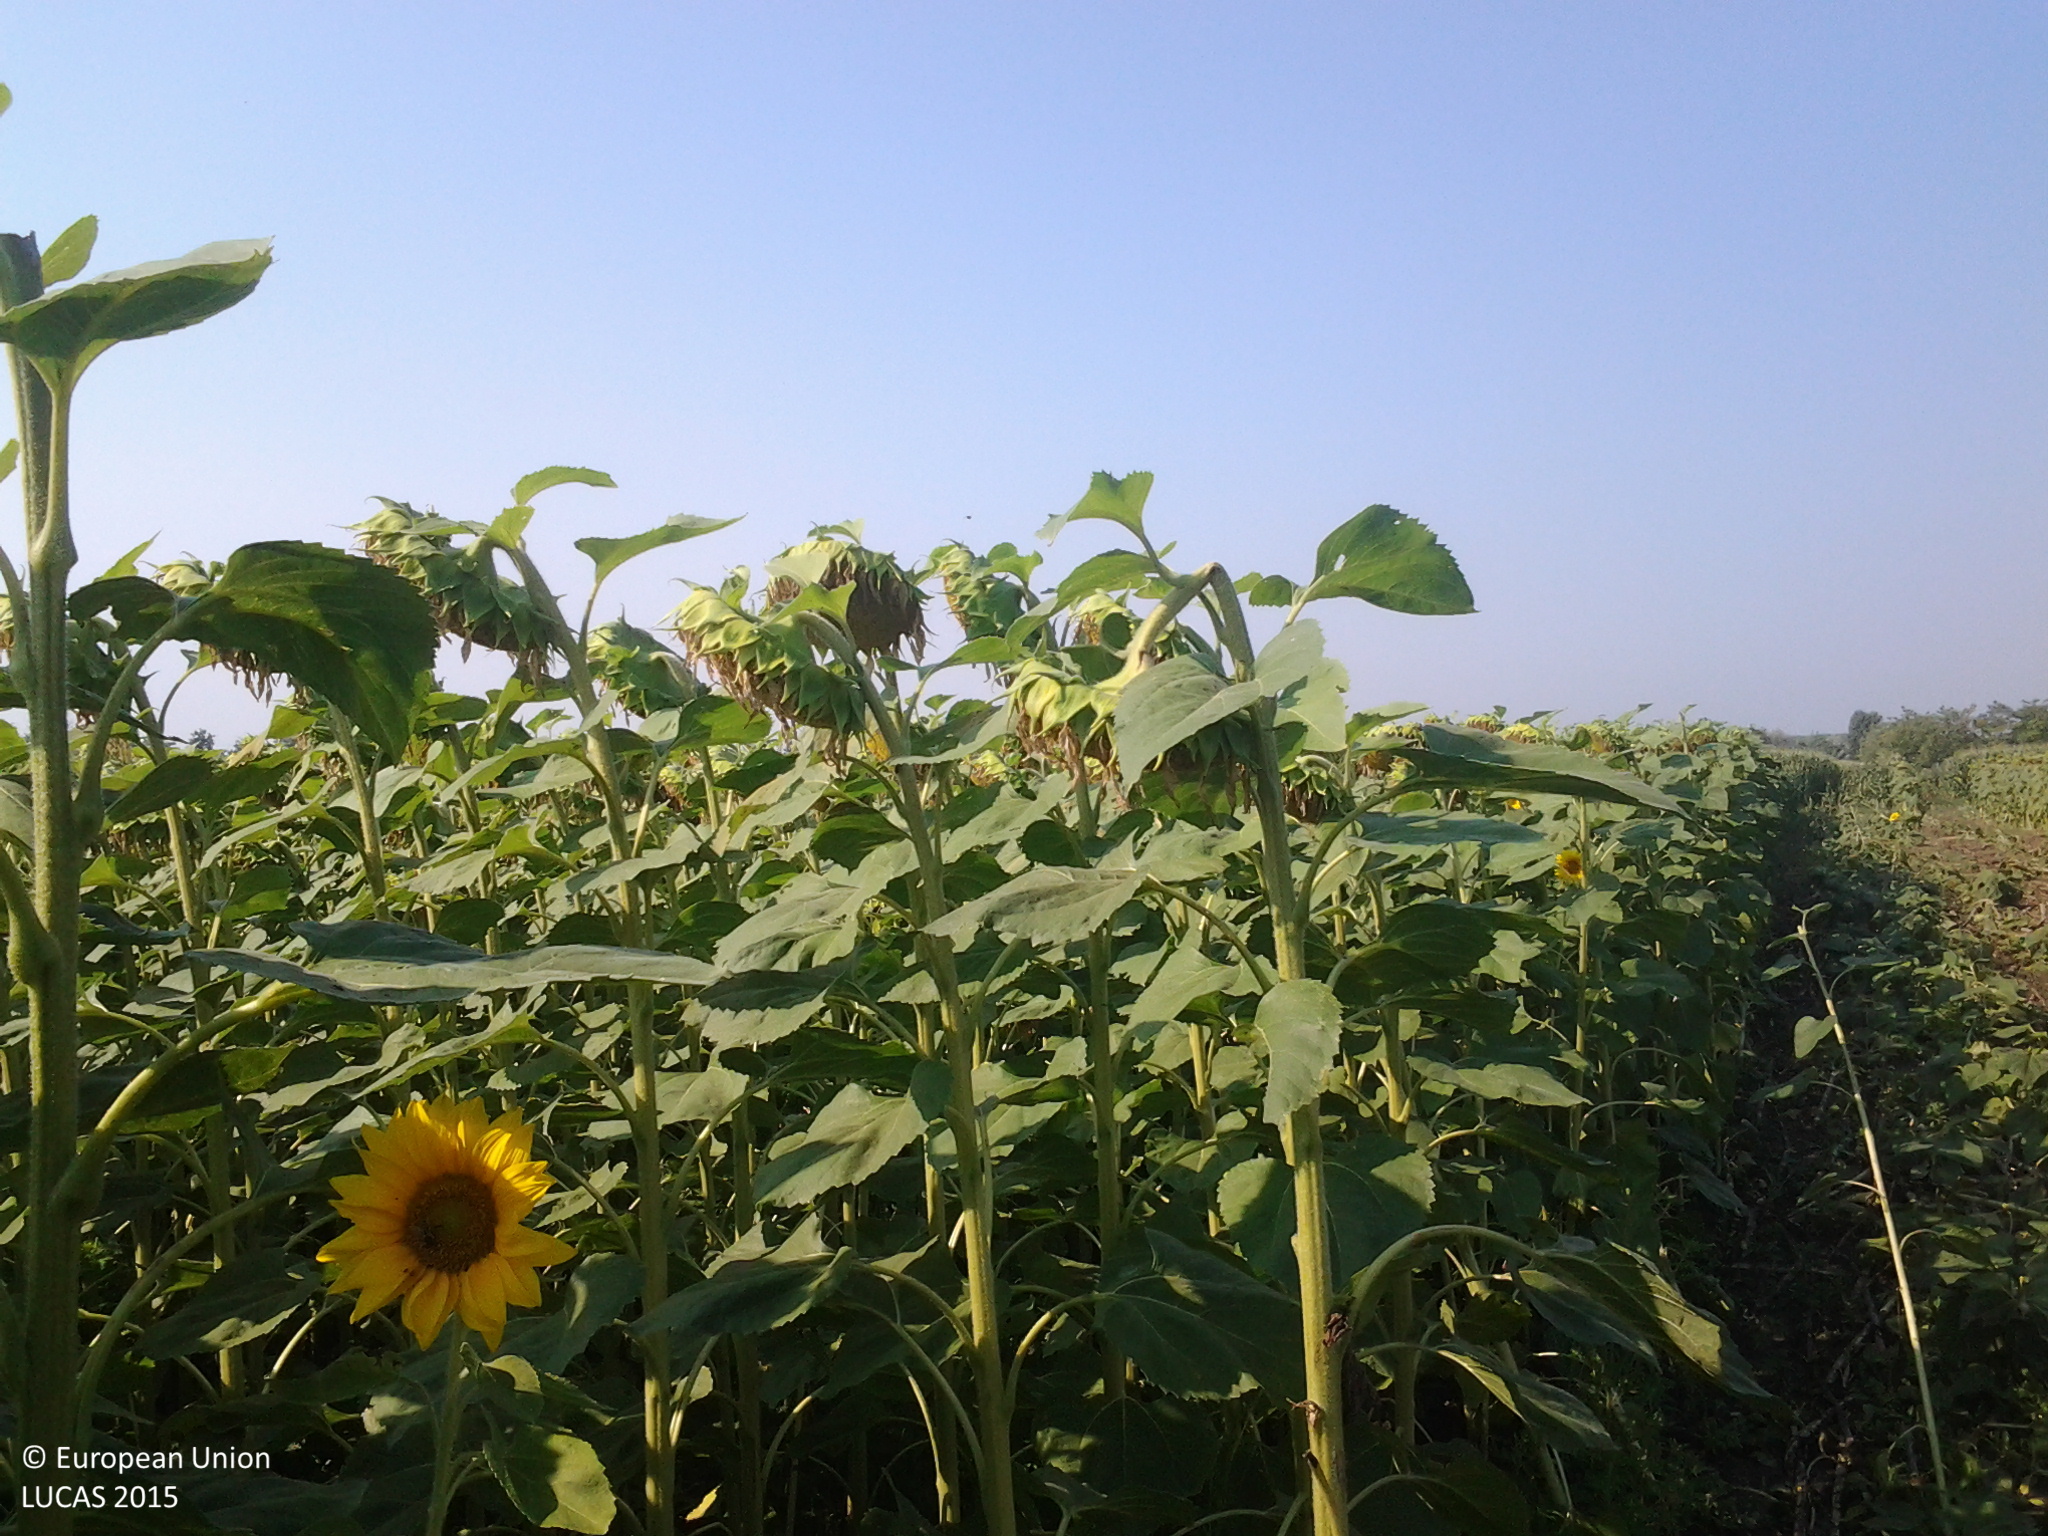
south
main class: Cropland
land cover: Sunflower
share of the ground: > 75 %
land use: Agriculture (excluding fallow land and kitchen gardens)
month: July
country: HU
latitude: 46.8188
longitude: 19.0459
